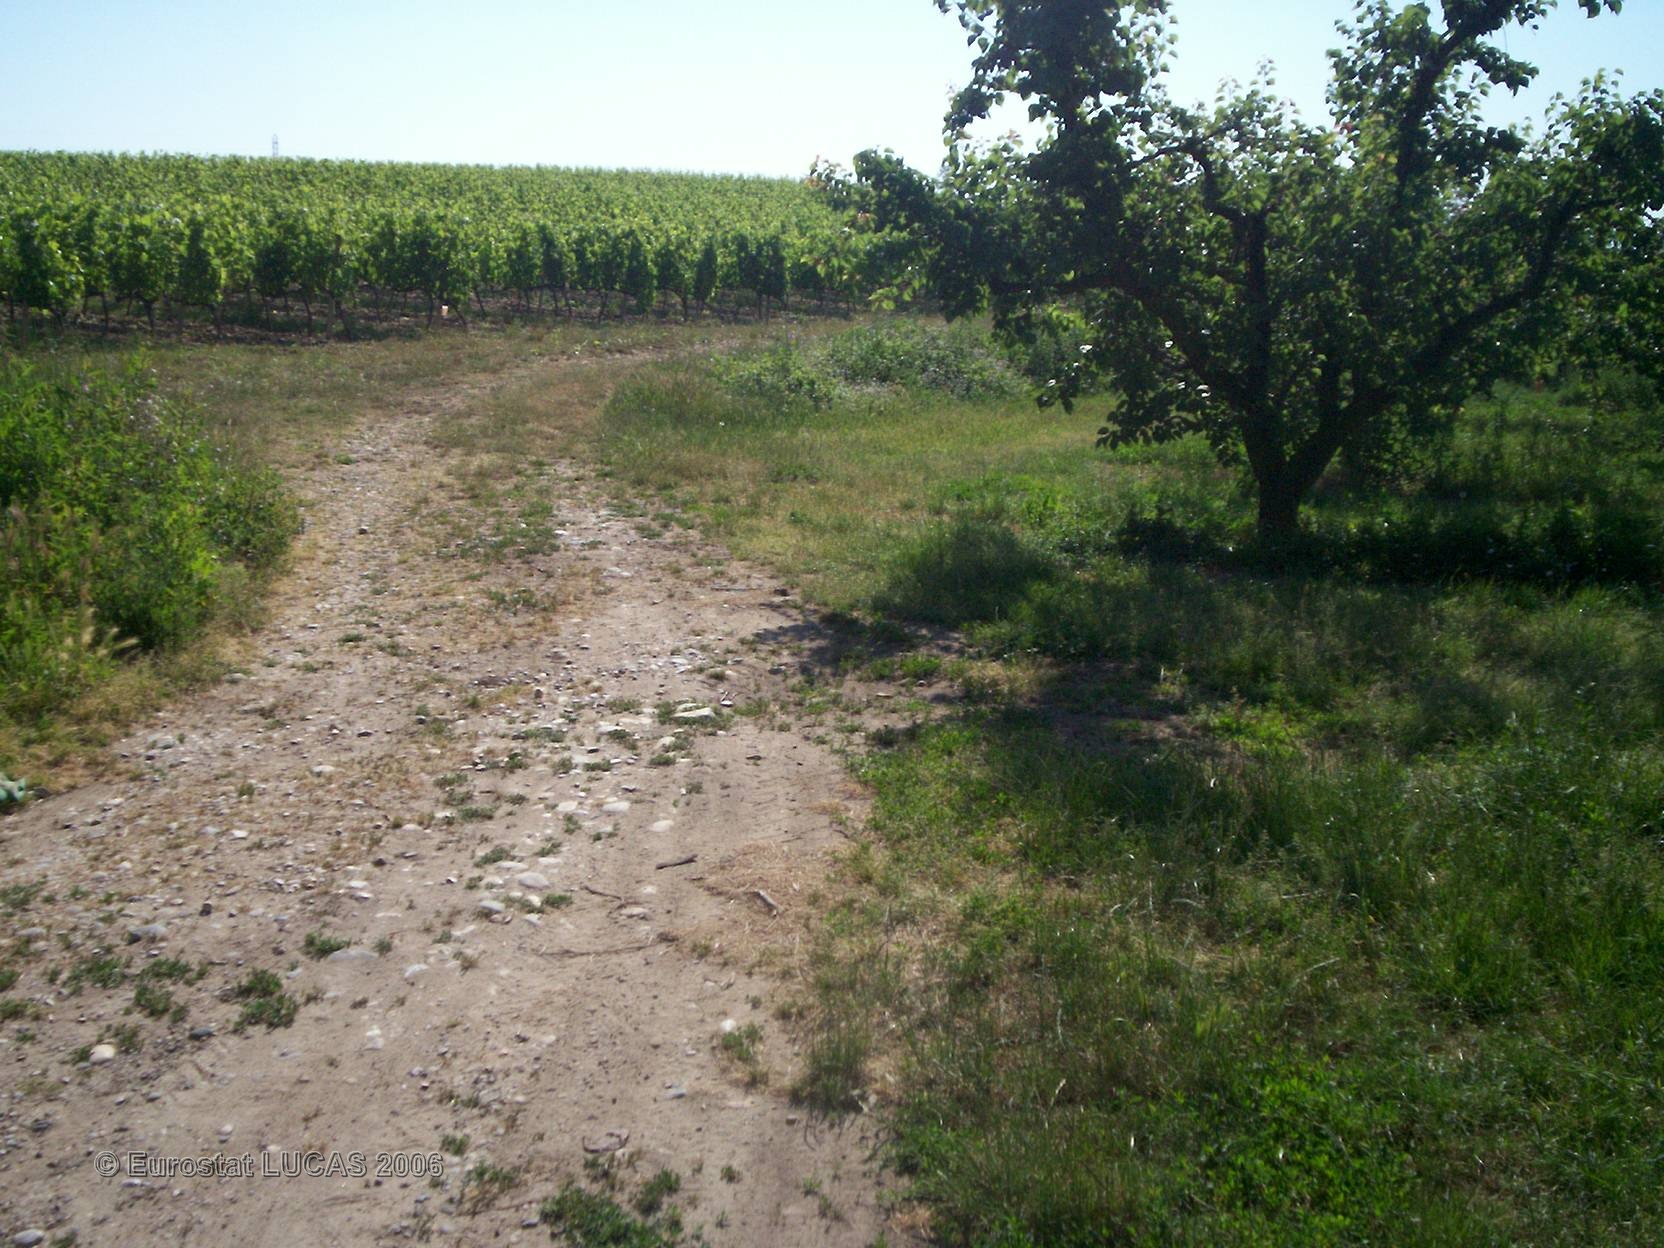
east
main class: Cropland
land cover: Other fruit trees and berries
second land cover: Grassland with sparse tree/shrub cover
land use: Agriculture (excluding fallow land and kitchen gardens)
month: June
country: FR
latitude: 45.0723
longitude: 4.8611
